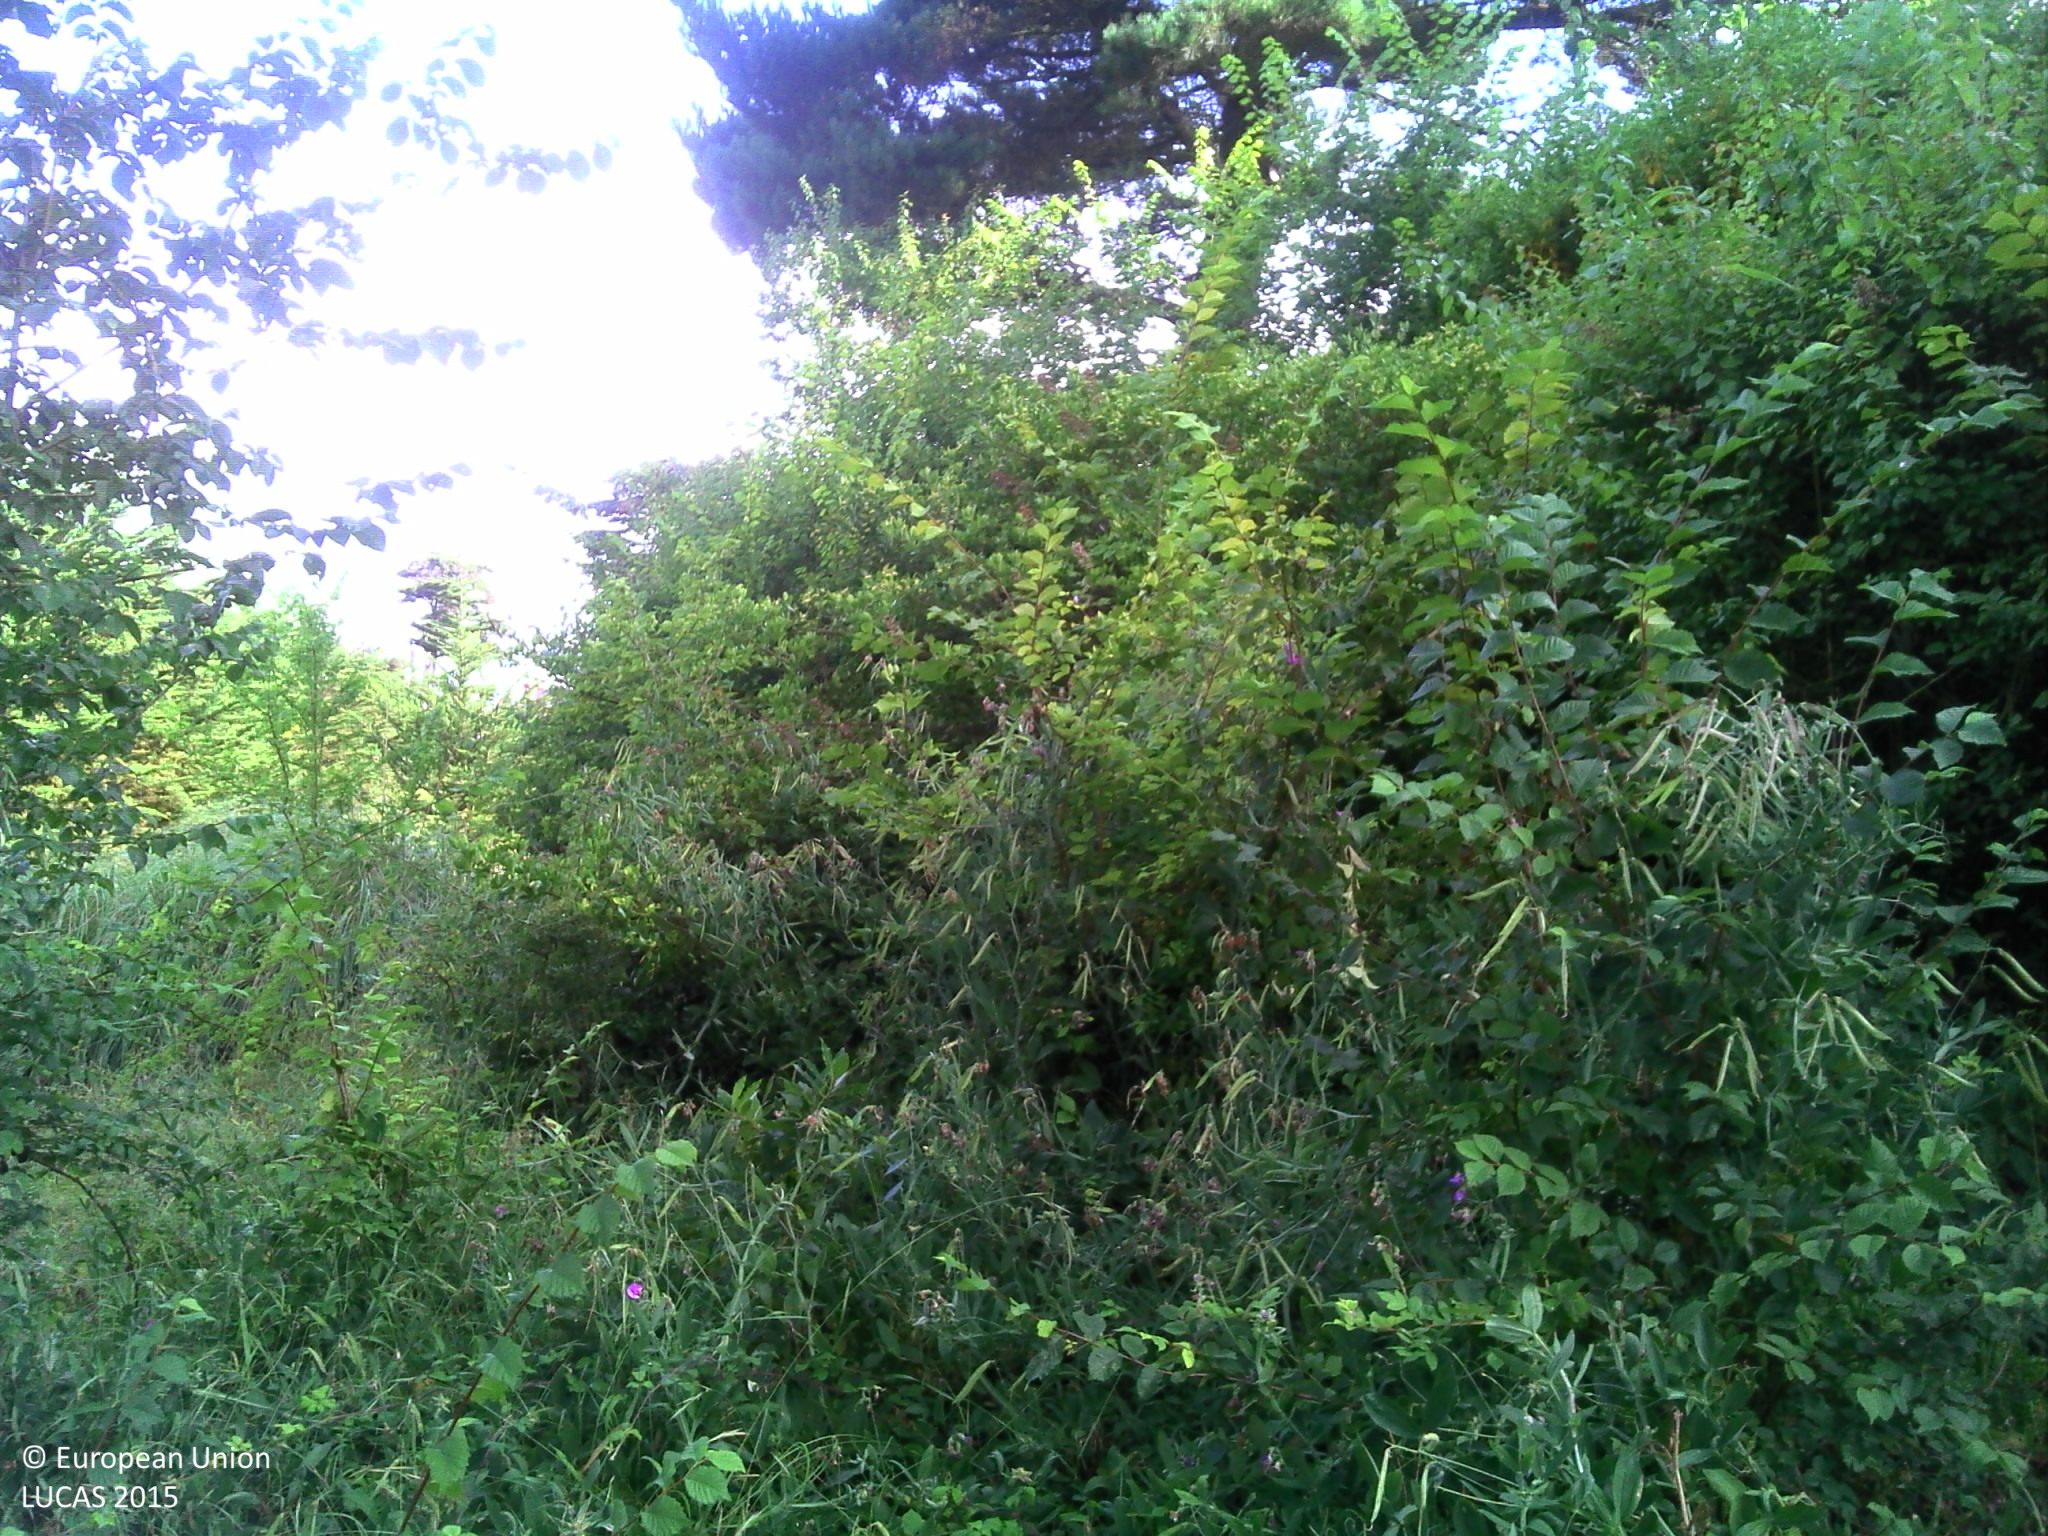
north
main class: Grassland
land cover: Grassland with sparse tree/shrub cover
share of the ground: > 75 %
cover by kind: herbaceous plants 65 %, consolidated bare surface 30 %, coniferous forest trees 5 %
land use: Residential
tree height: > 5 m
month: July
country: FR
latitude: 48.5990
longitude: -2.1936
